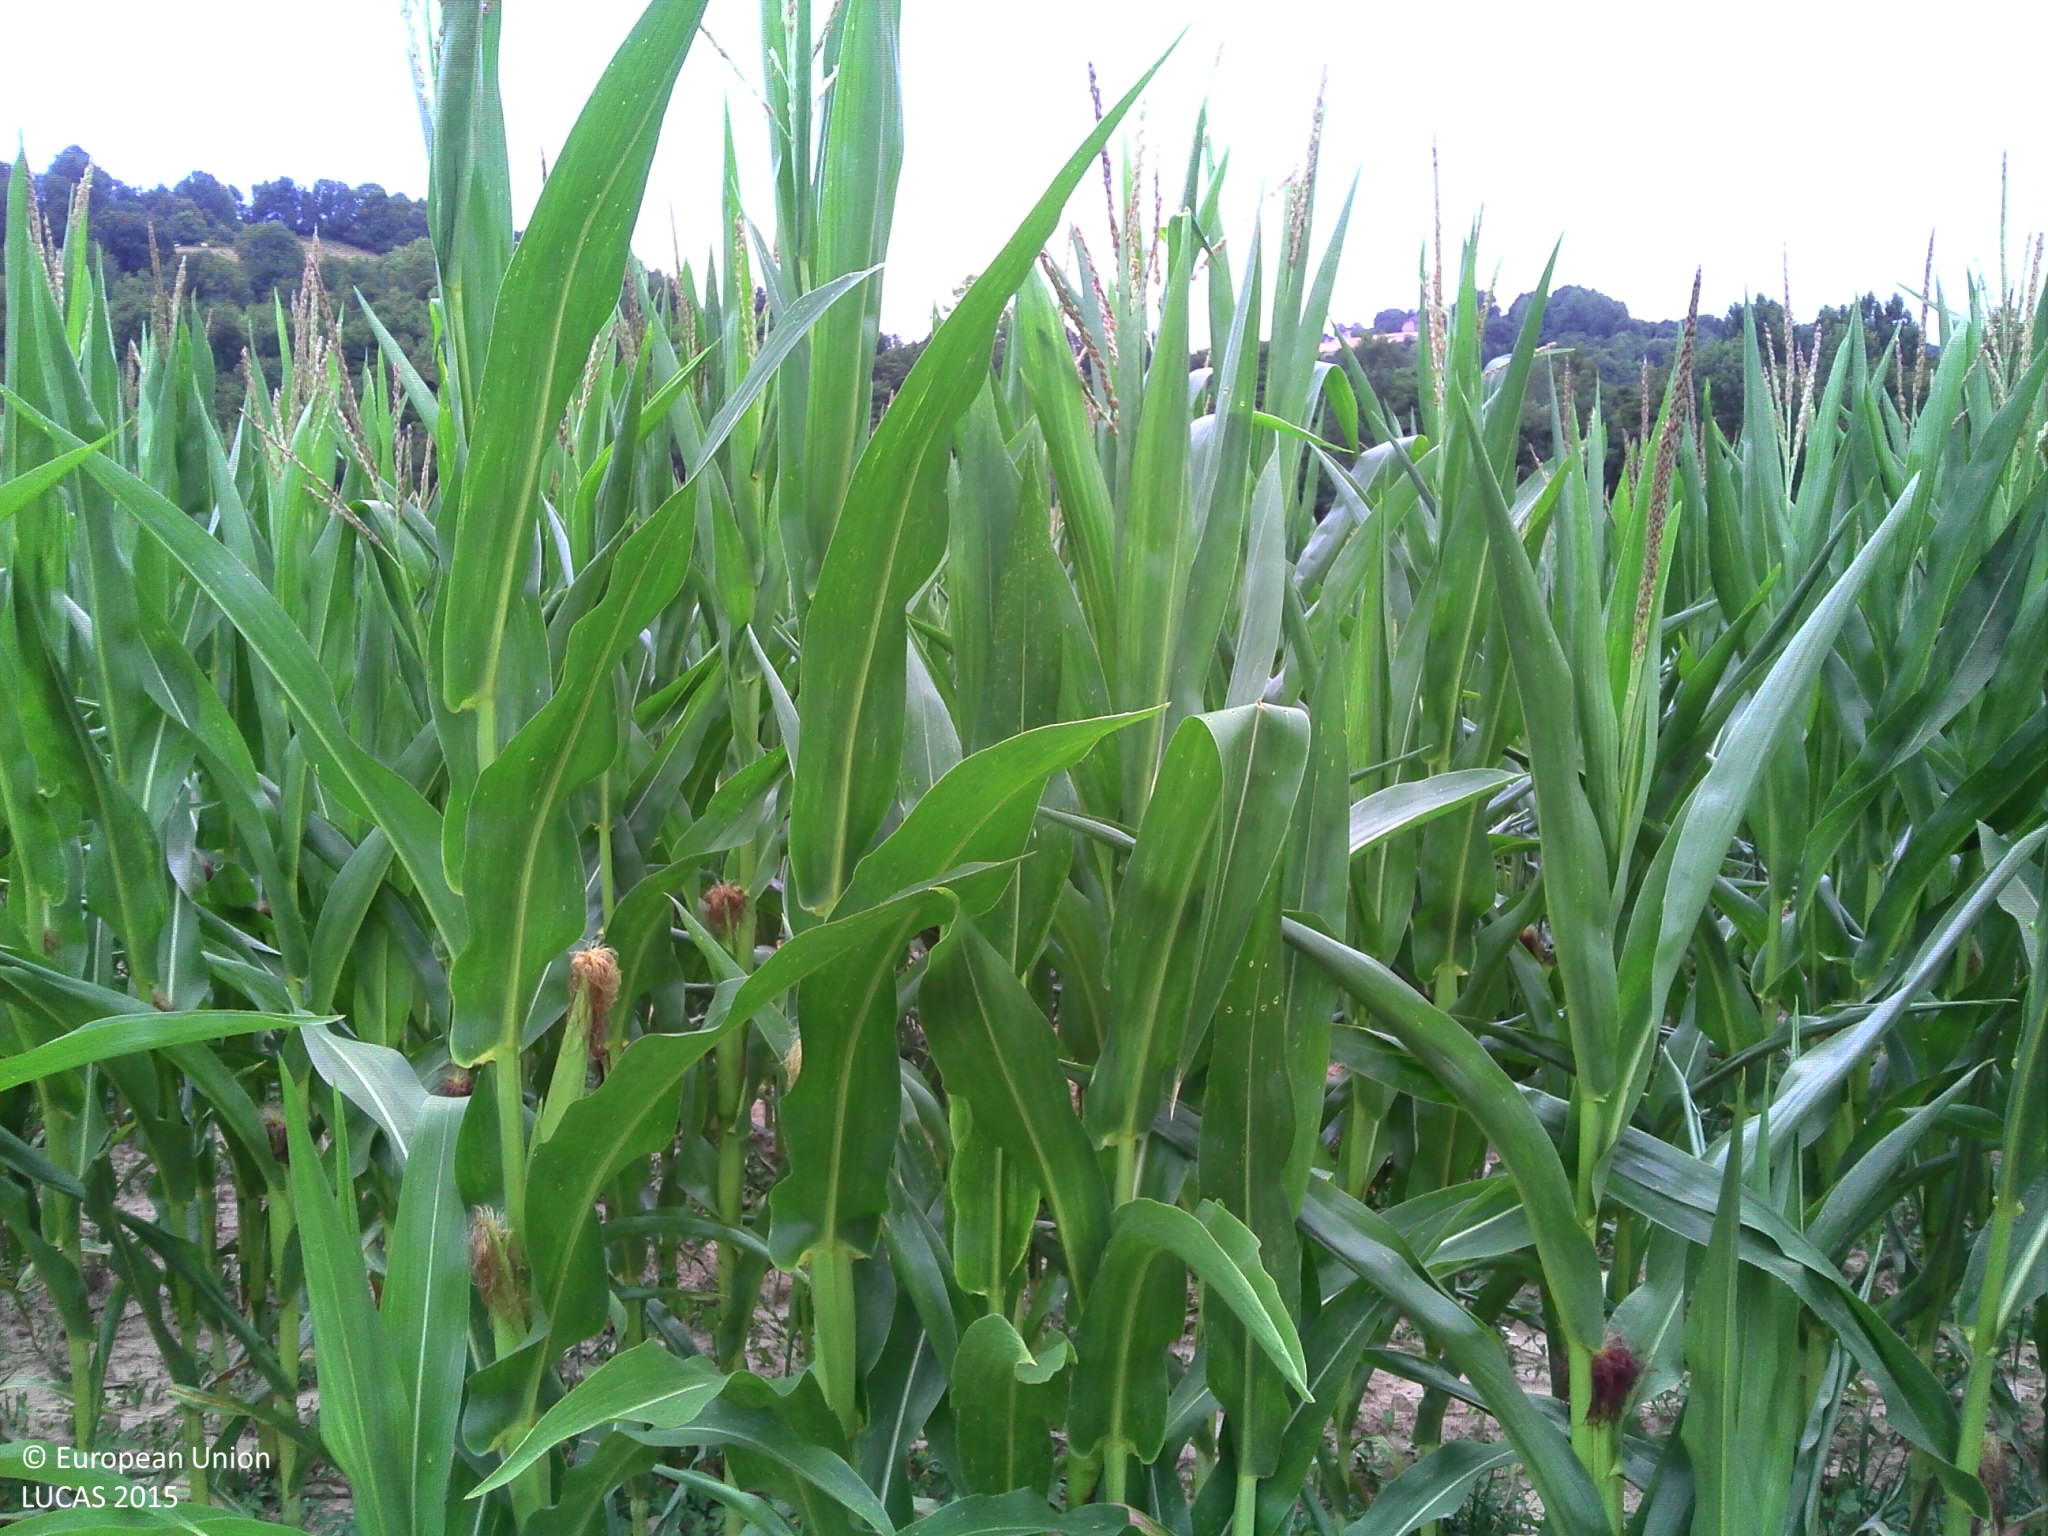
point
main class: Cropland
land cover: Maize
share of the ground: > 75 %
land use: Agriculture (excluding fallow land and kitchen gardens)
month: July
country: FR
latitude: 45.4392
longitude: 4.9804
